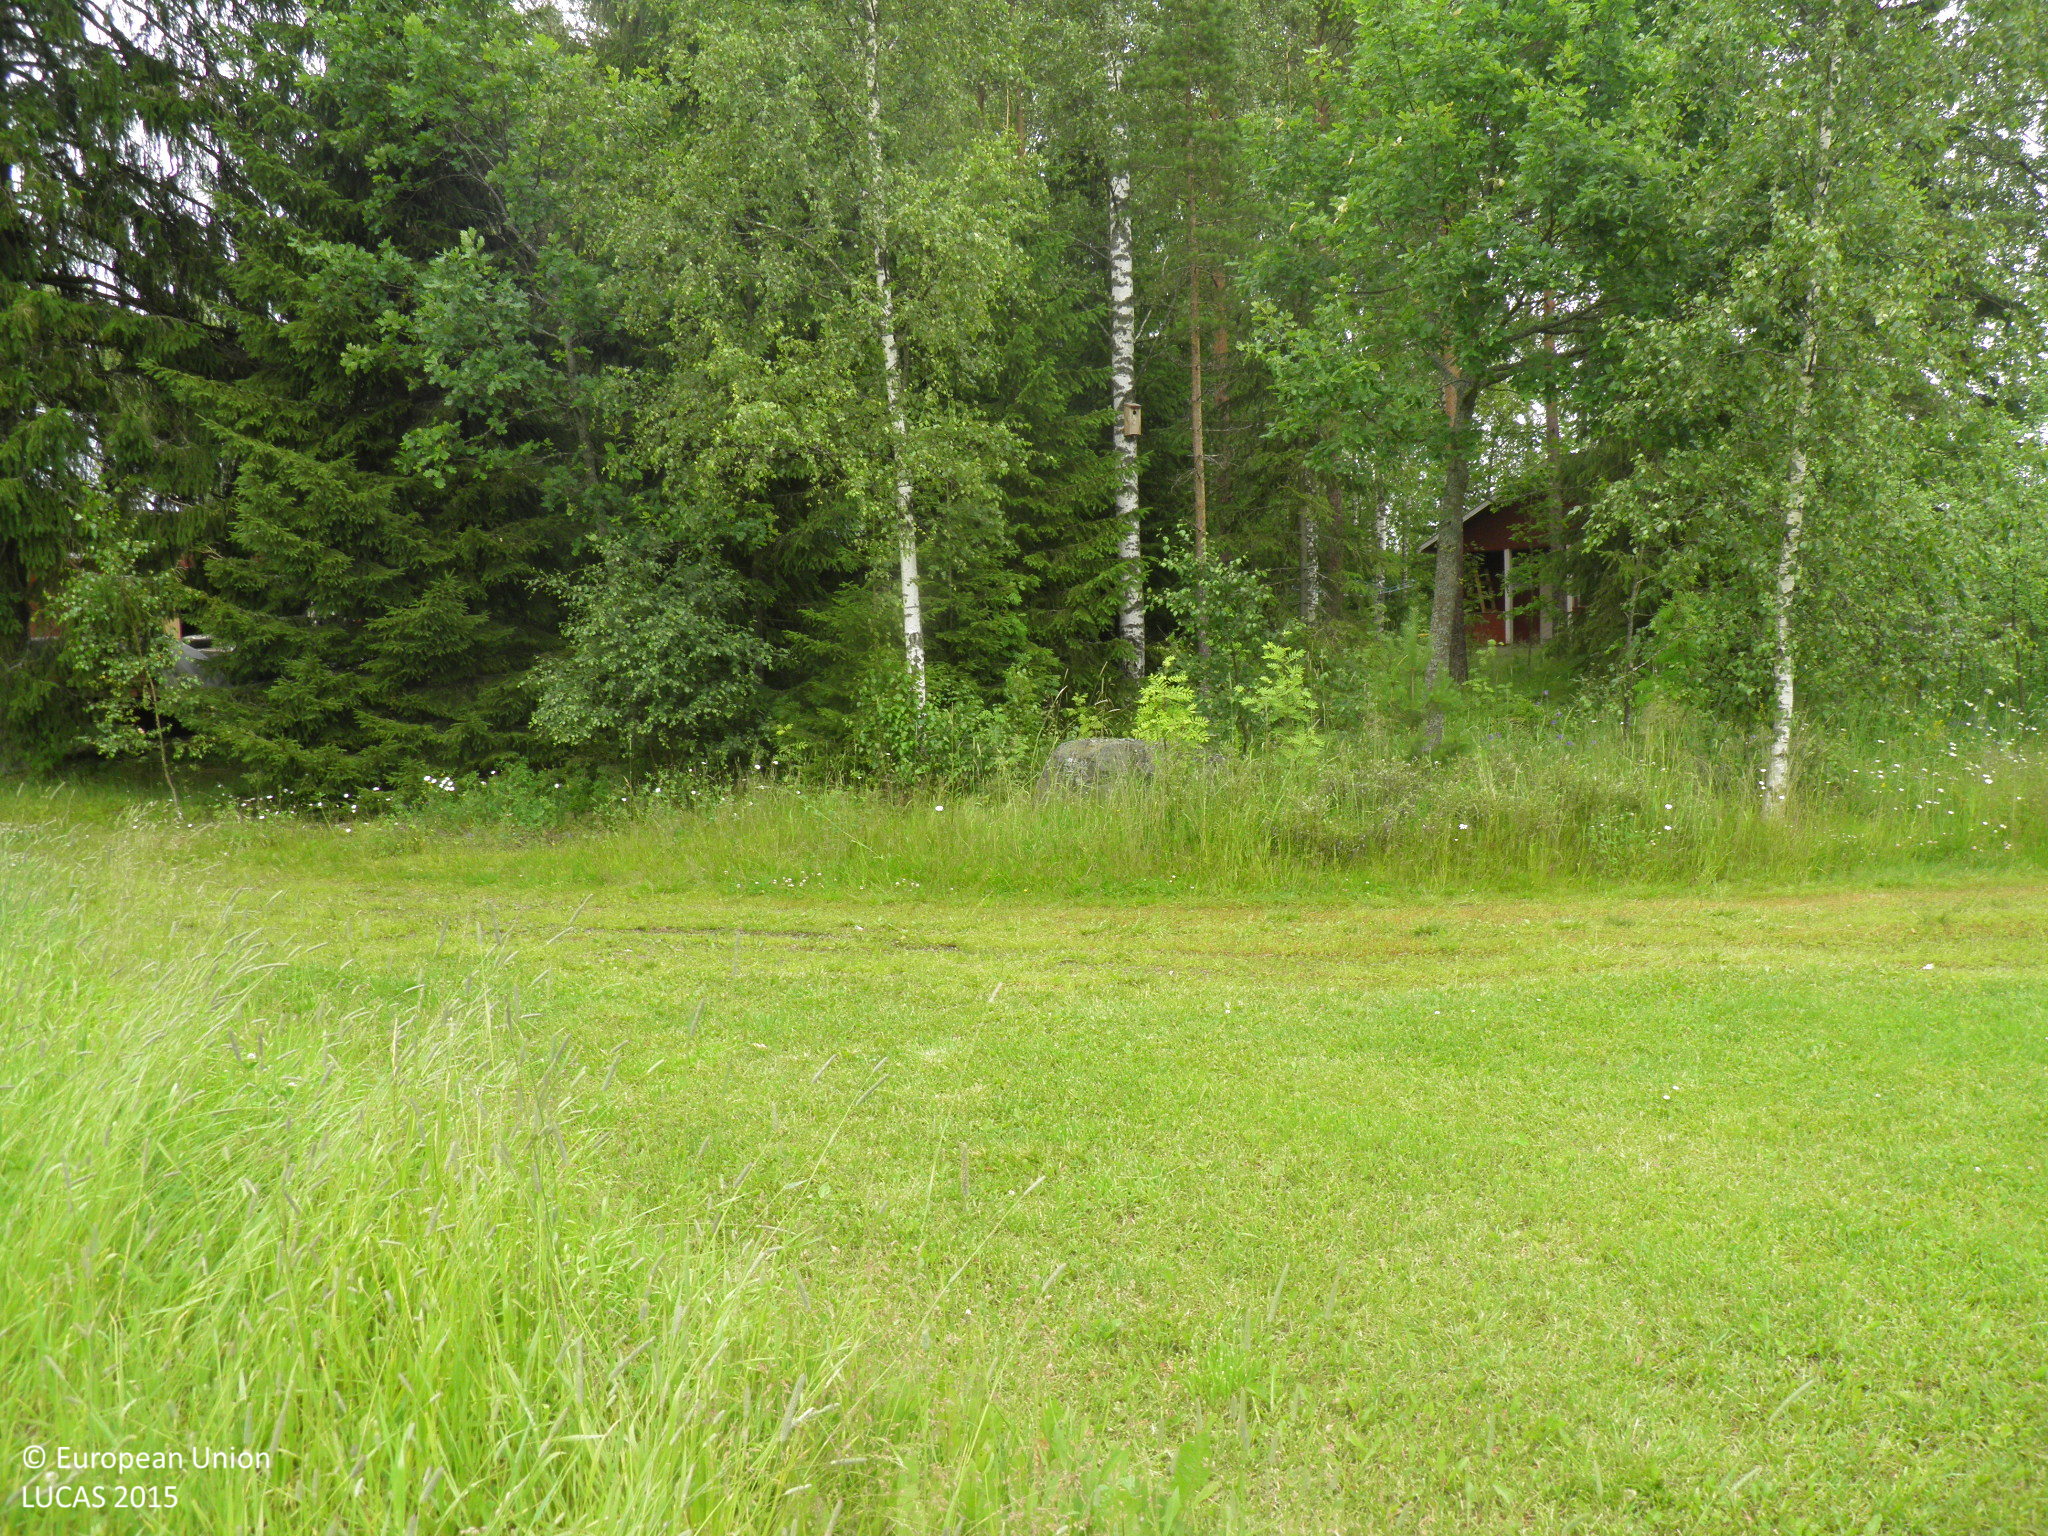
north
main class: Cropland
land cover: Temporary grasslands
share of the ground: > 75 %
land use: Agriculture (excluding fallow land and kitchen gardens)
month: July
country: FI
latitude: 60.6844
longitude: 22.8732
